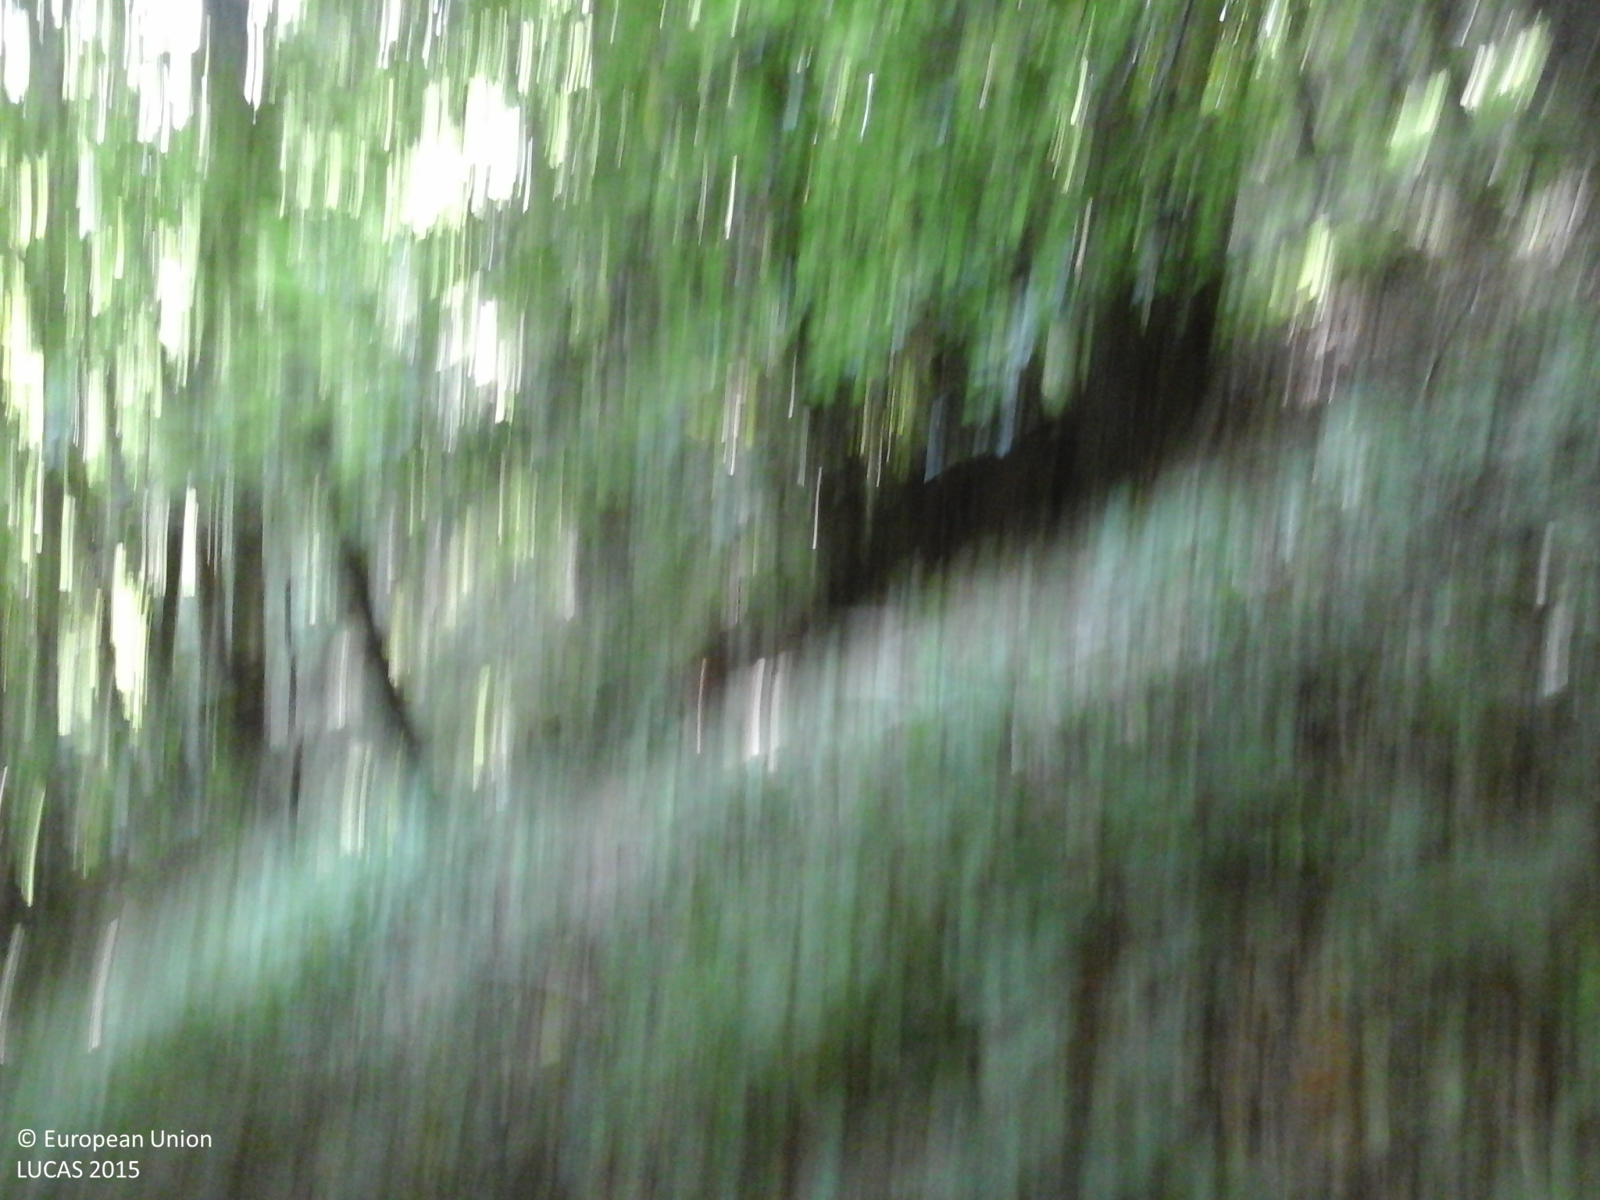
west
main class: Woodland
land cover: Broadleaved woodland
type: thermophilous deciduous forest
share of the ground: > 75 %
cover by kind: broadleaved forest trees 90 %, shrubs 10 %
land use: Forestry
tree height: > 5 m
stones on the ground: < 10 %
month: June
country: IT
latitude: 44.5867
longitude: 7.3224
